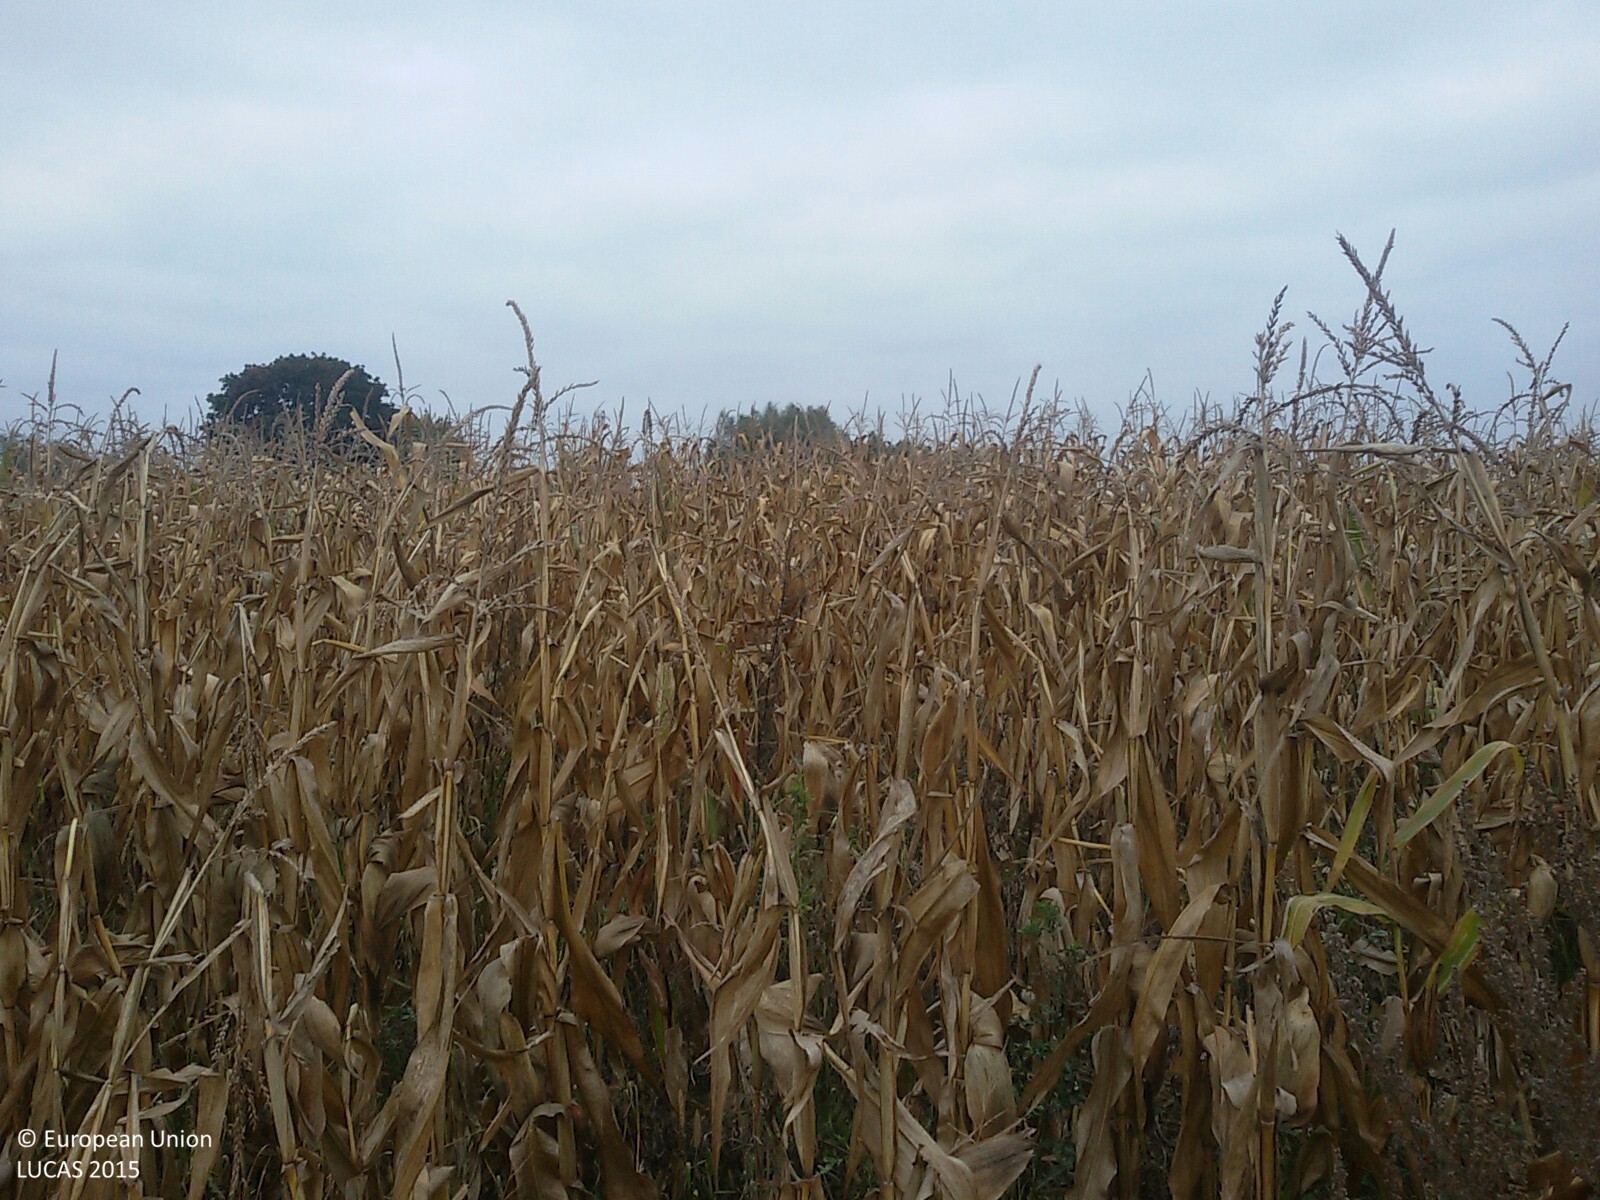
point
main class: Cropland
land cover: Maize
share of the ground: > 75 %
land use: Agriculture (excluding fallow land and kitchen gardens)
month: October
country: PL
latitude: 53.3205
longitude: 19.2268
